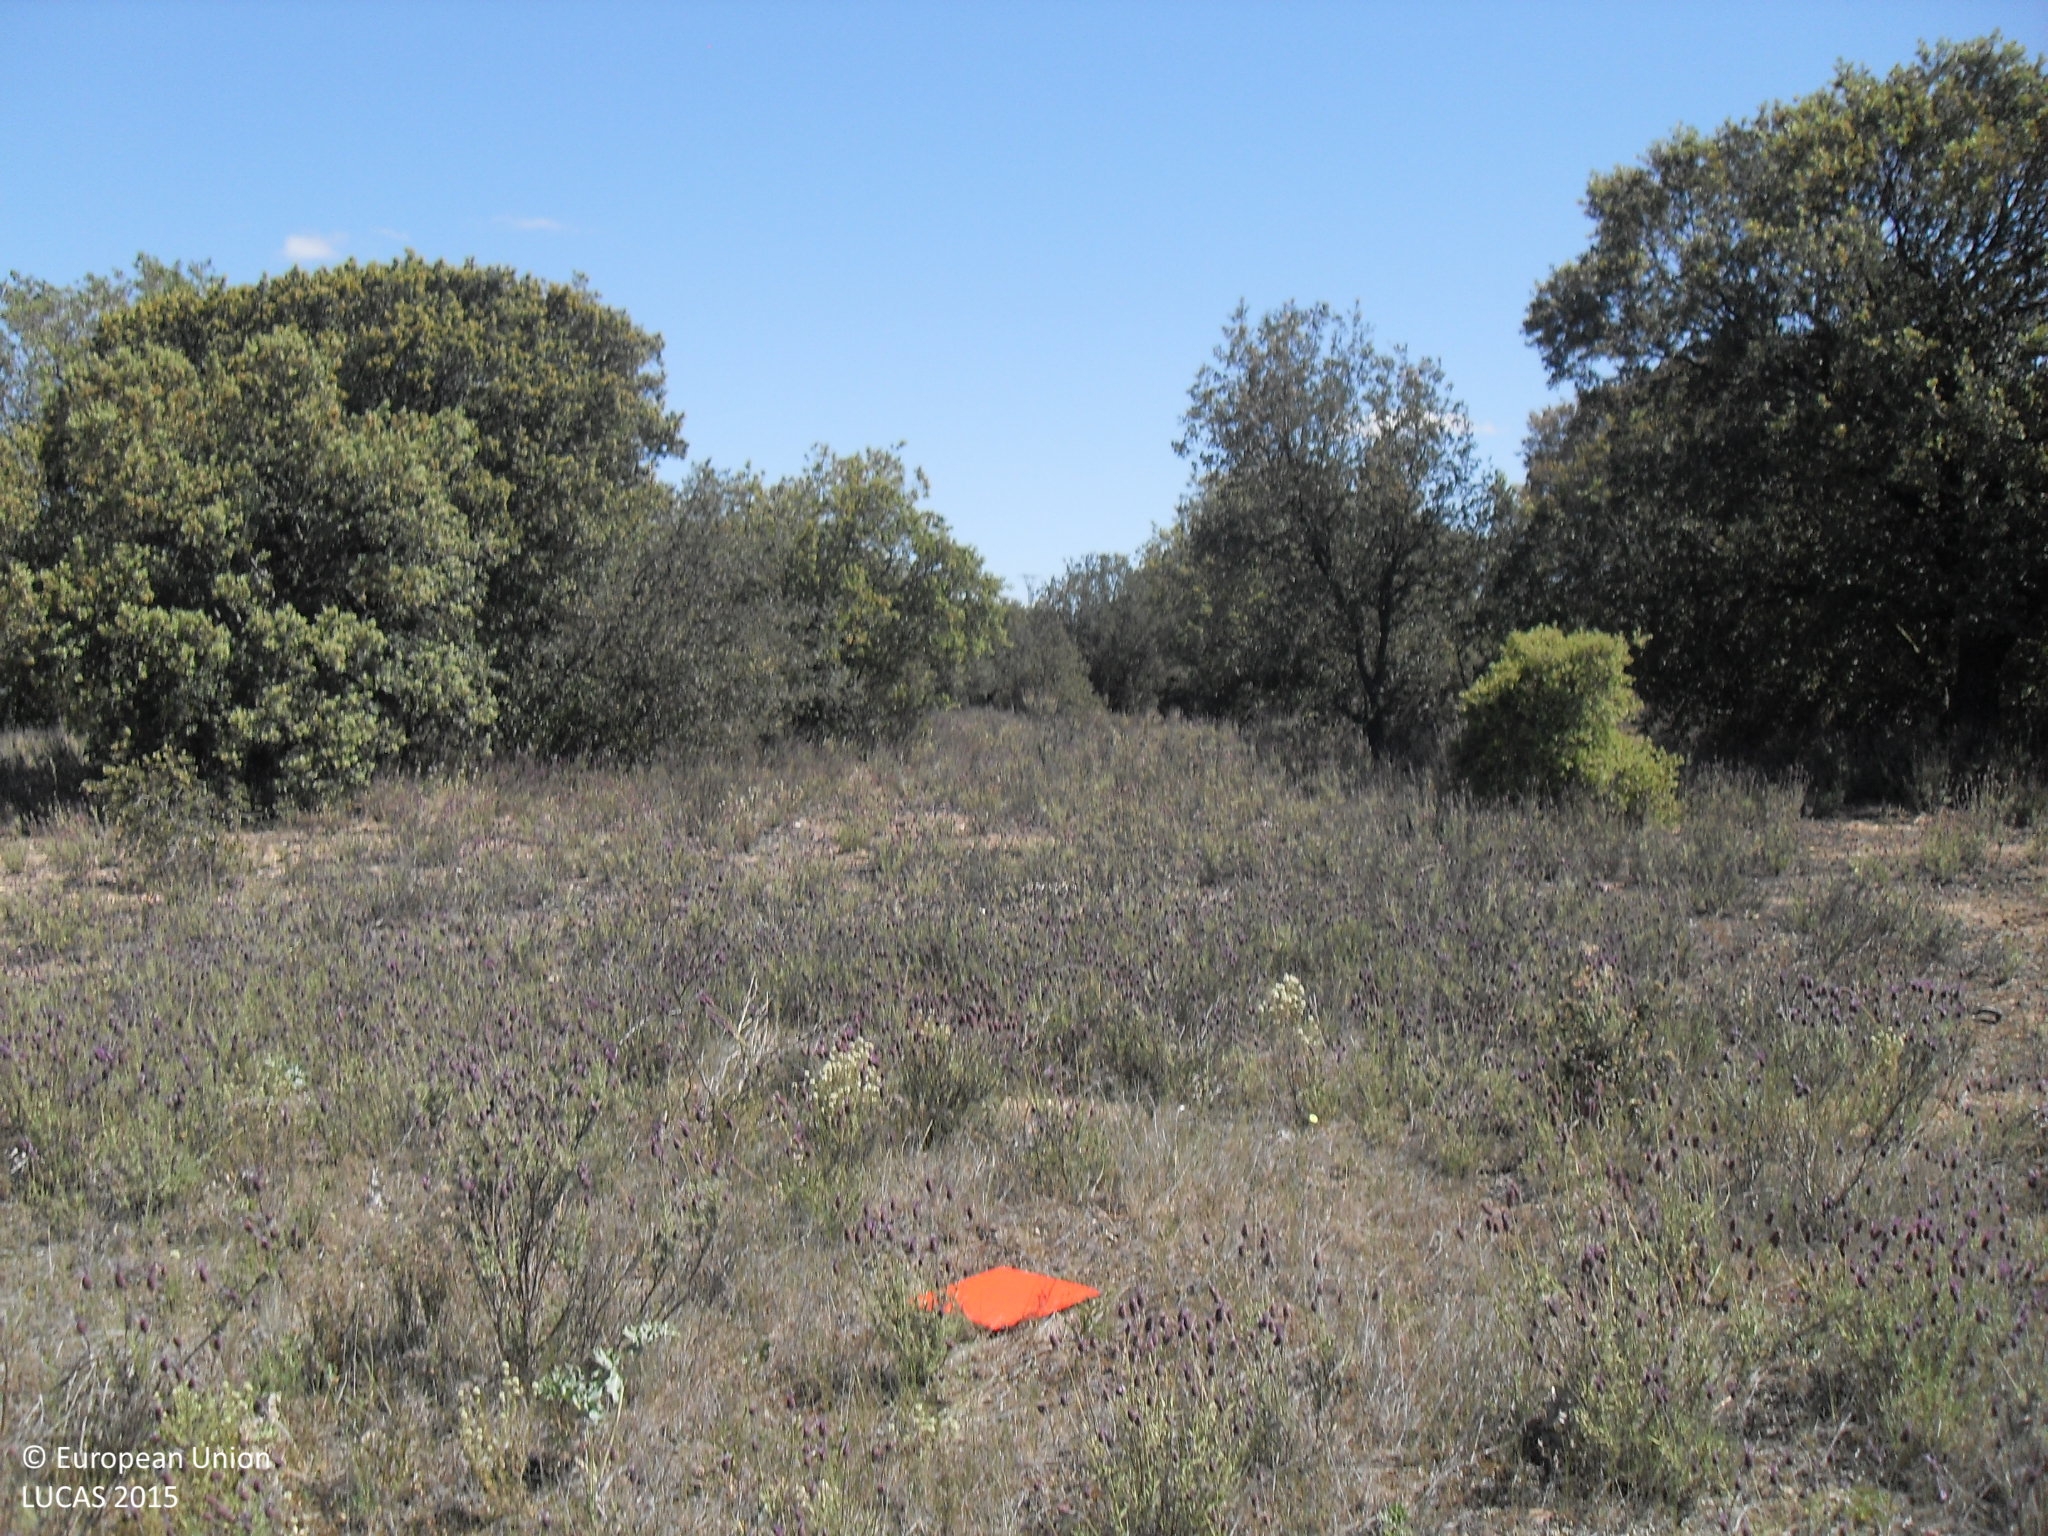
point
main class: Grassland
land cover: Grassland with sparse tree/shrub cover
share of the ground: > 75 %
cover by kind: herbaceous plants 85 %, shrubs 10 %, broadleaved forest trees 5 %
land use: Agriculture (excluding fallow land and kitchen gardens)
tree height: < 5 m
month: May
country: ES
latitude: 41.1159
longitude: -5.3046
